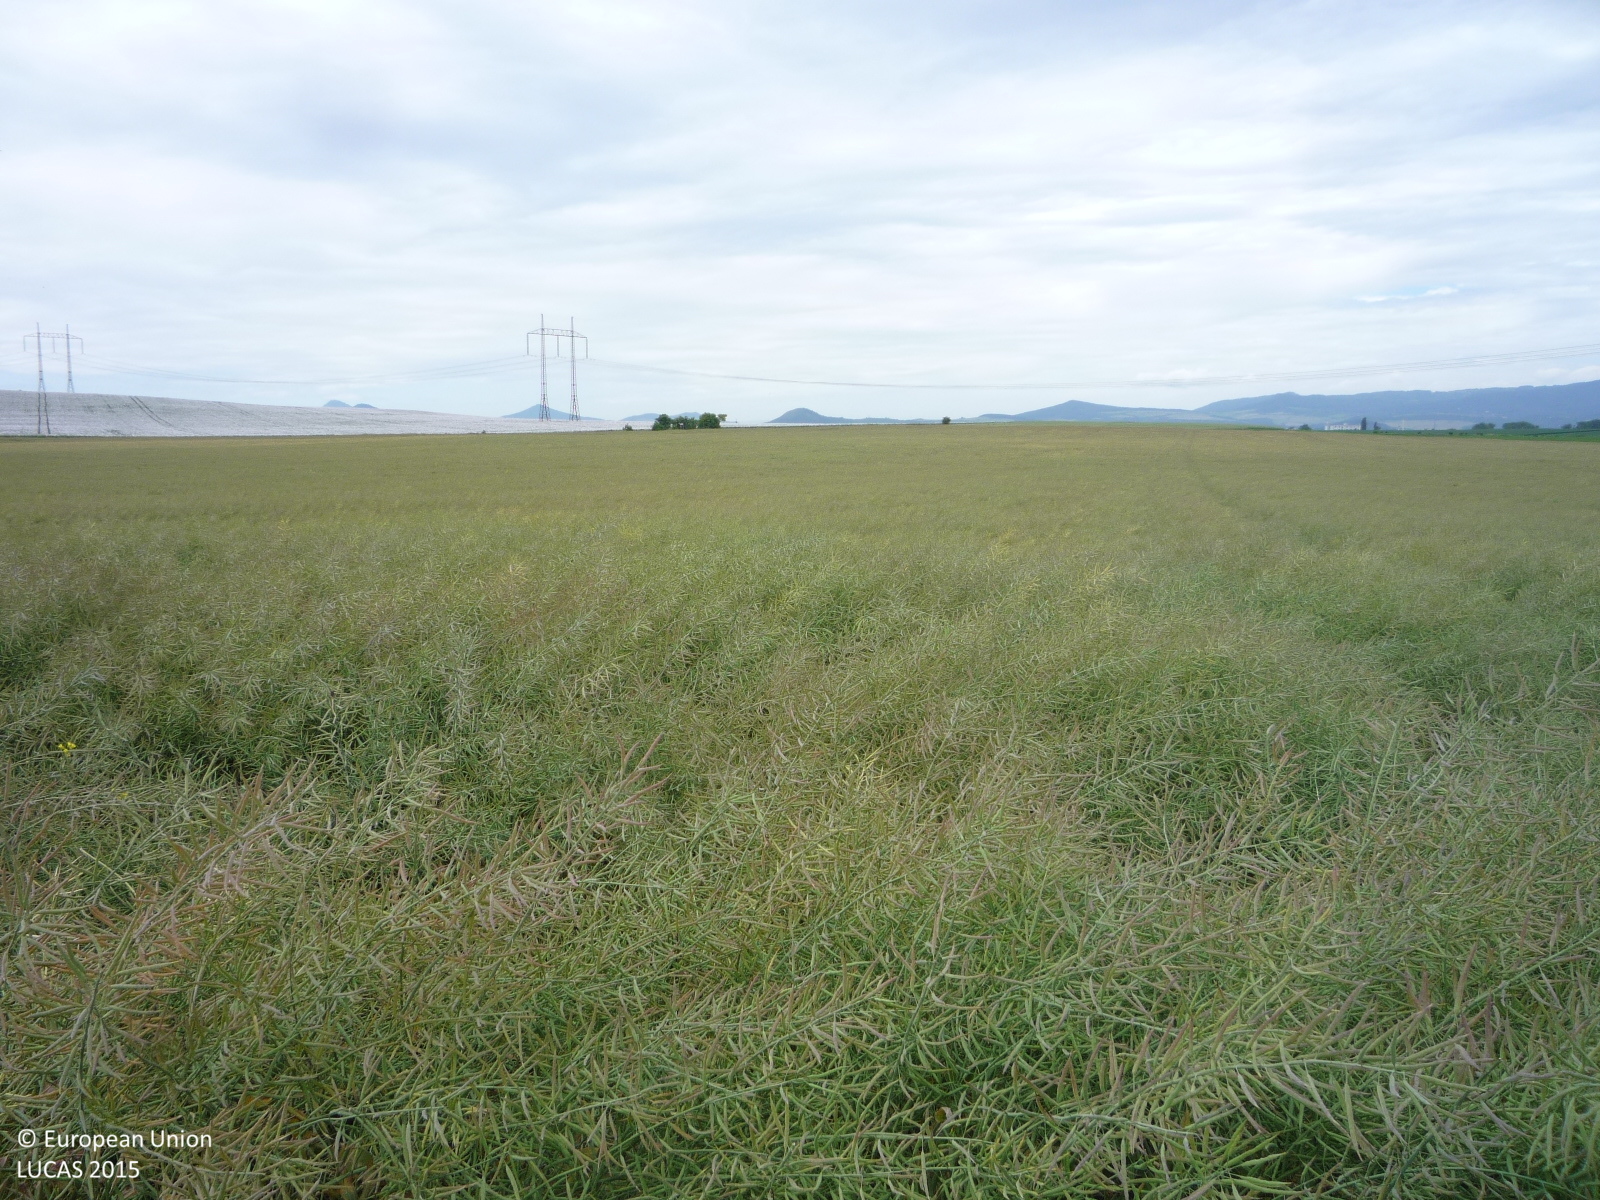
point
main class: Cropland
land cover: Rape and turnip rape
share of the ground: > 75 %
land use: Agriculture (excluding fallow land and kitchen gardens)
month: June
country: CZ
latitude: 50.4676
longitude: 14.1856
